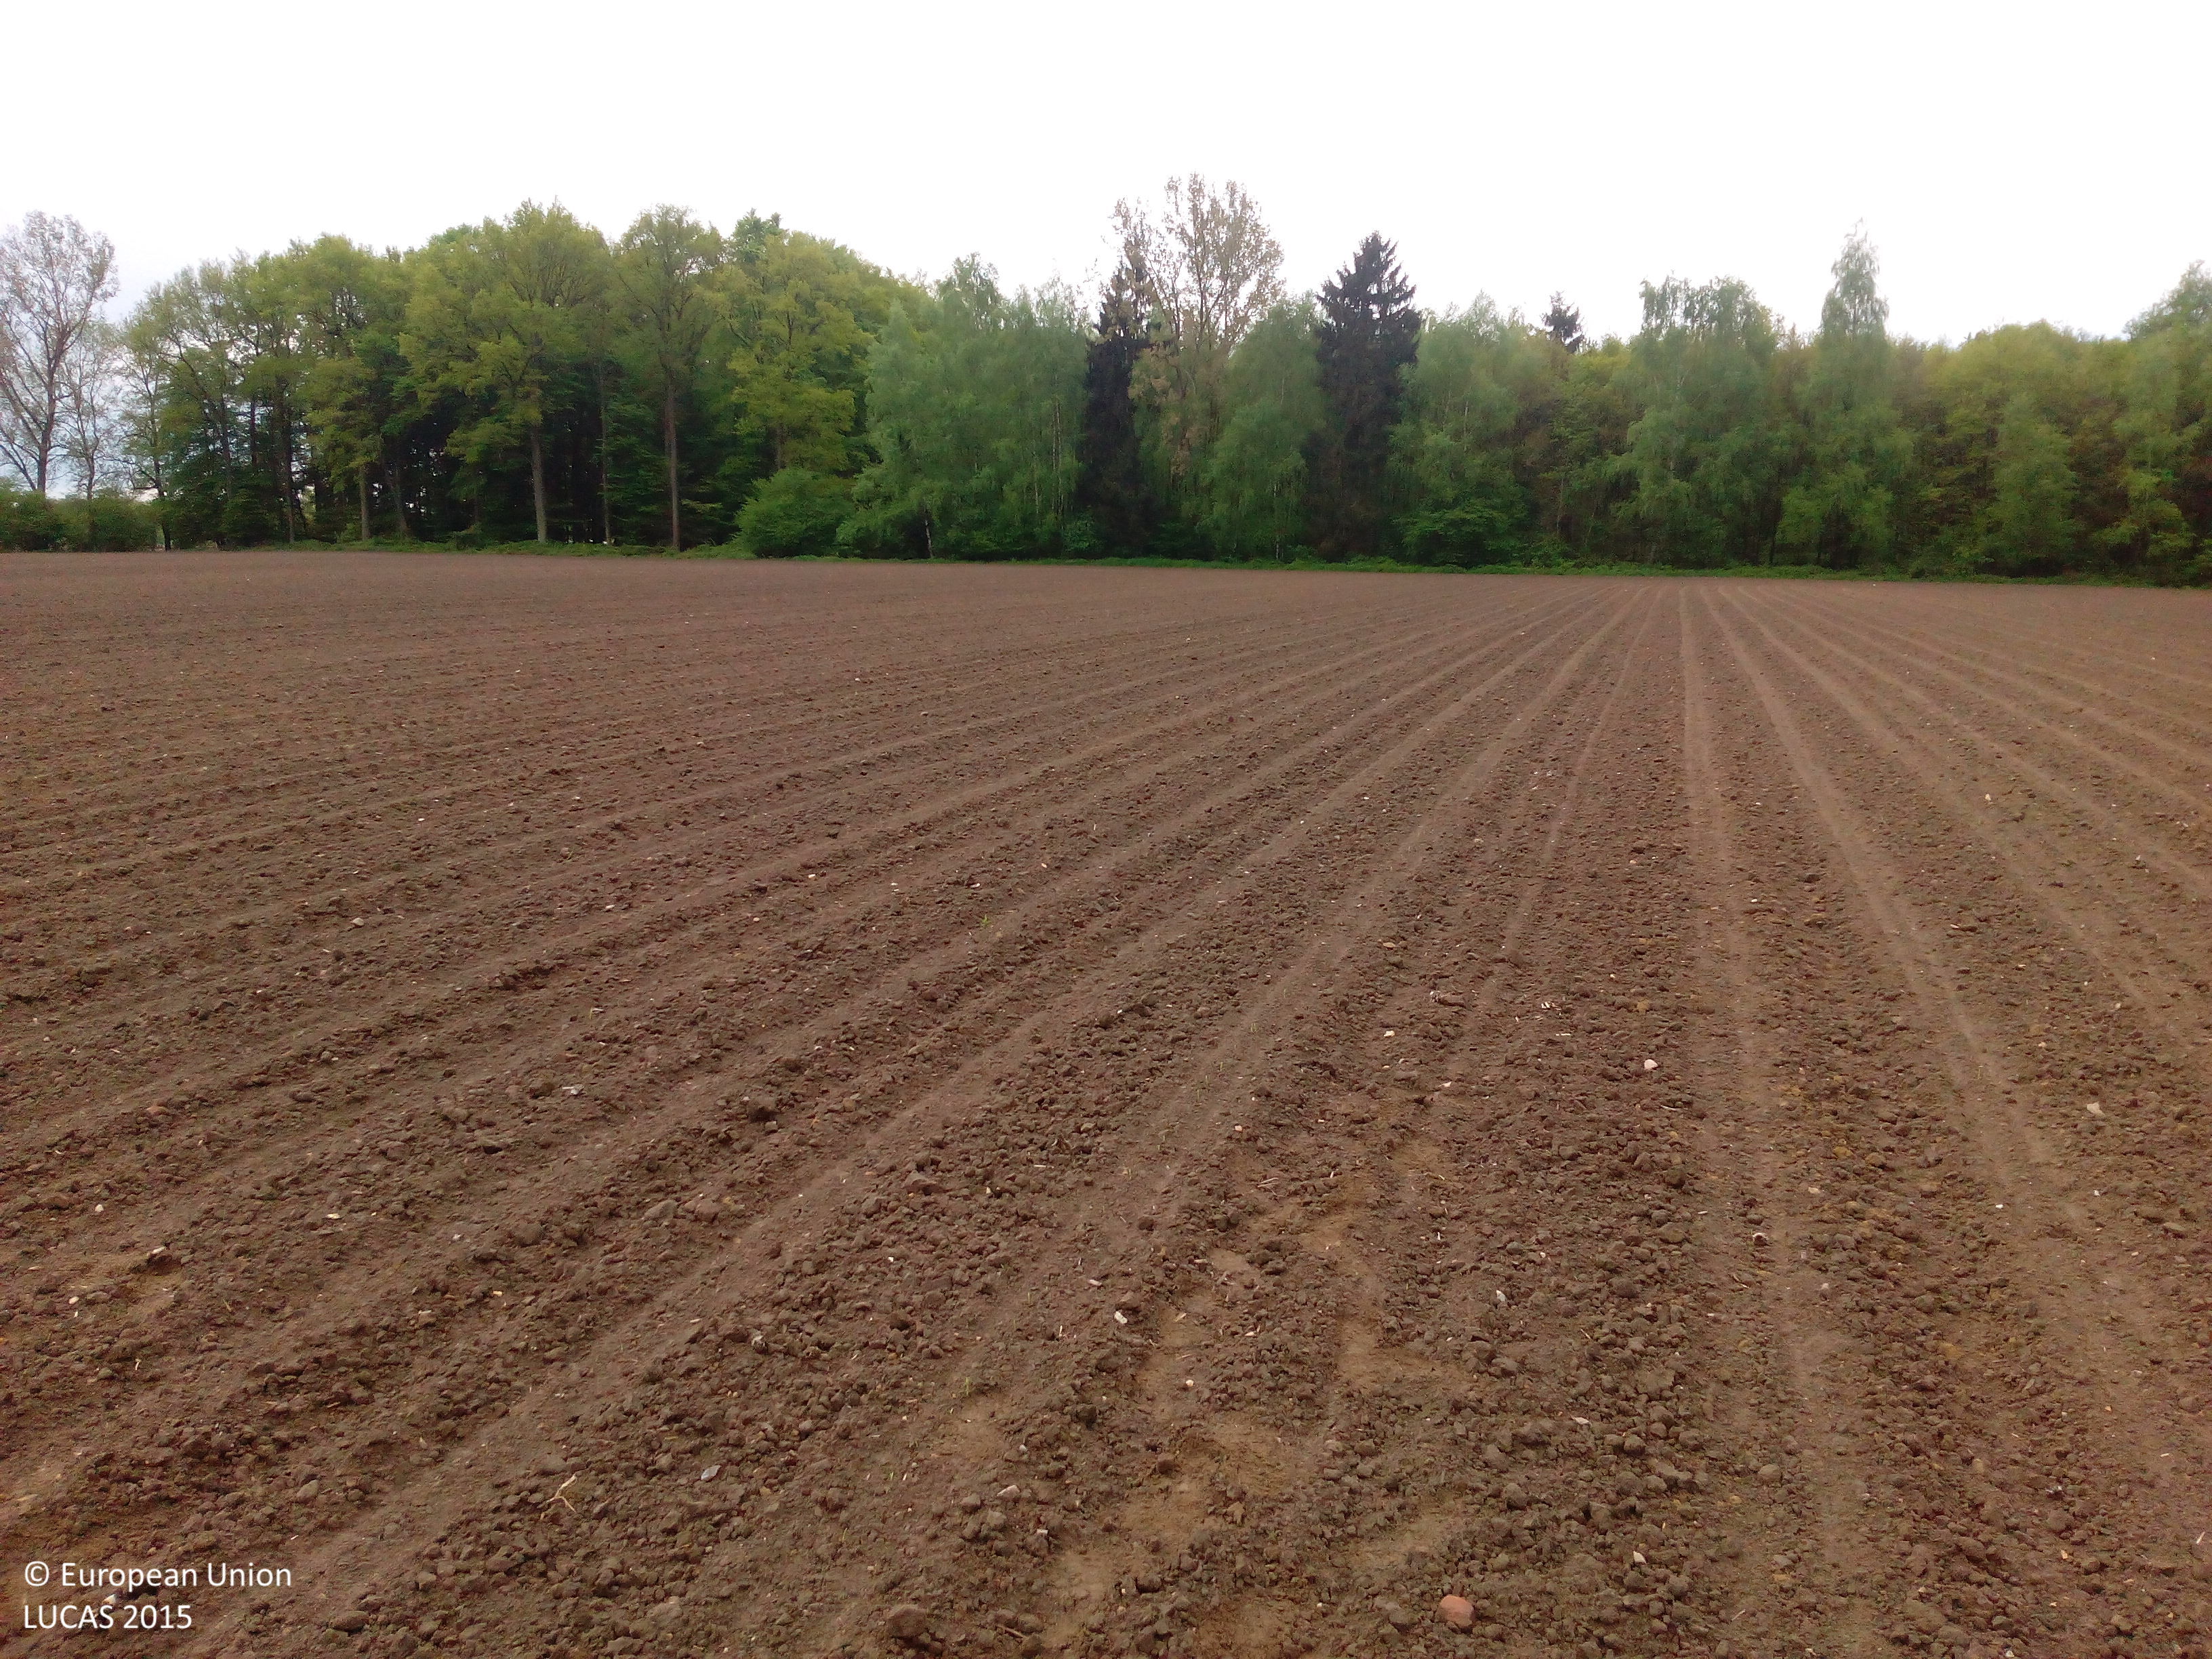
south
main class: Cropland
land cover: Maize
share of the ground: < 10 %
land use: Agriculture (excluding fallow land and kitchen gardens)
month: May
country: DE
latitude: 51.8288
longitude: 7.4610
